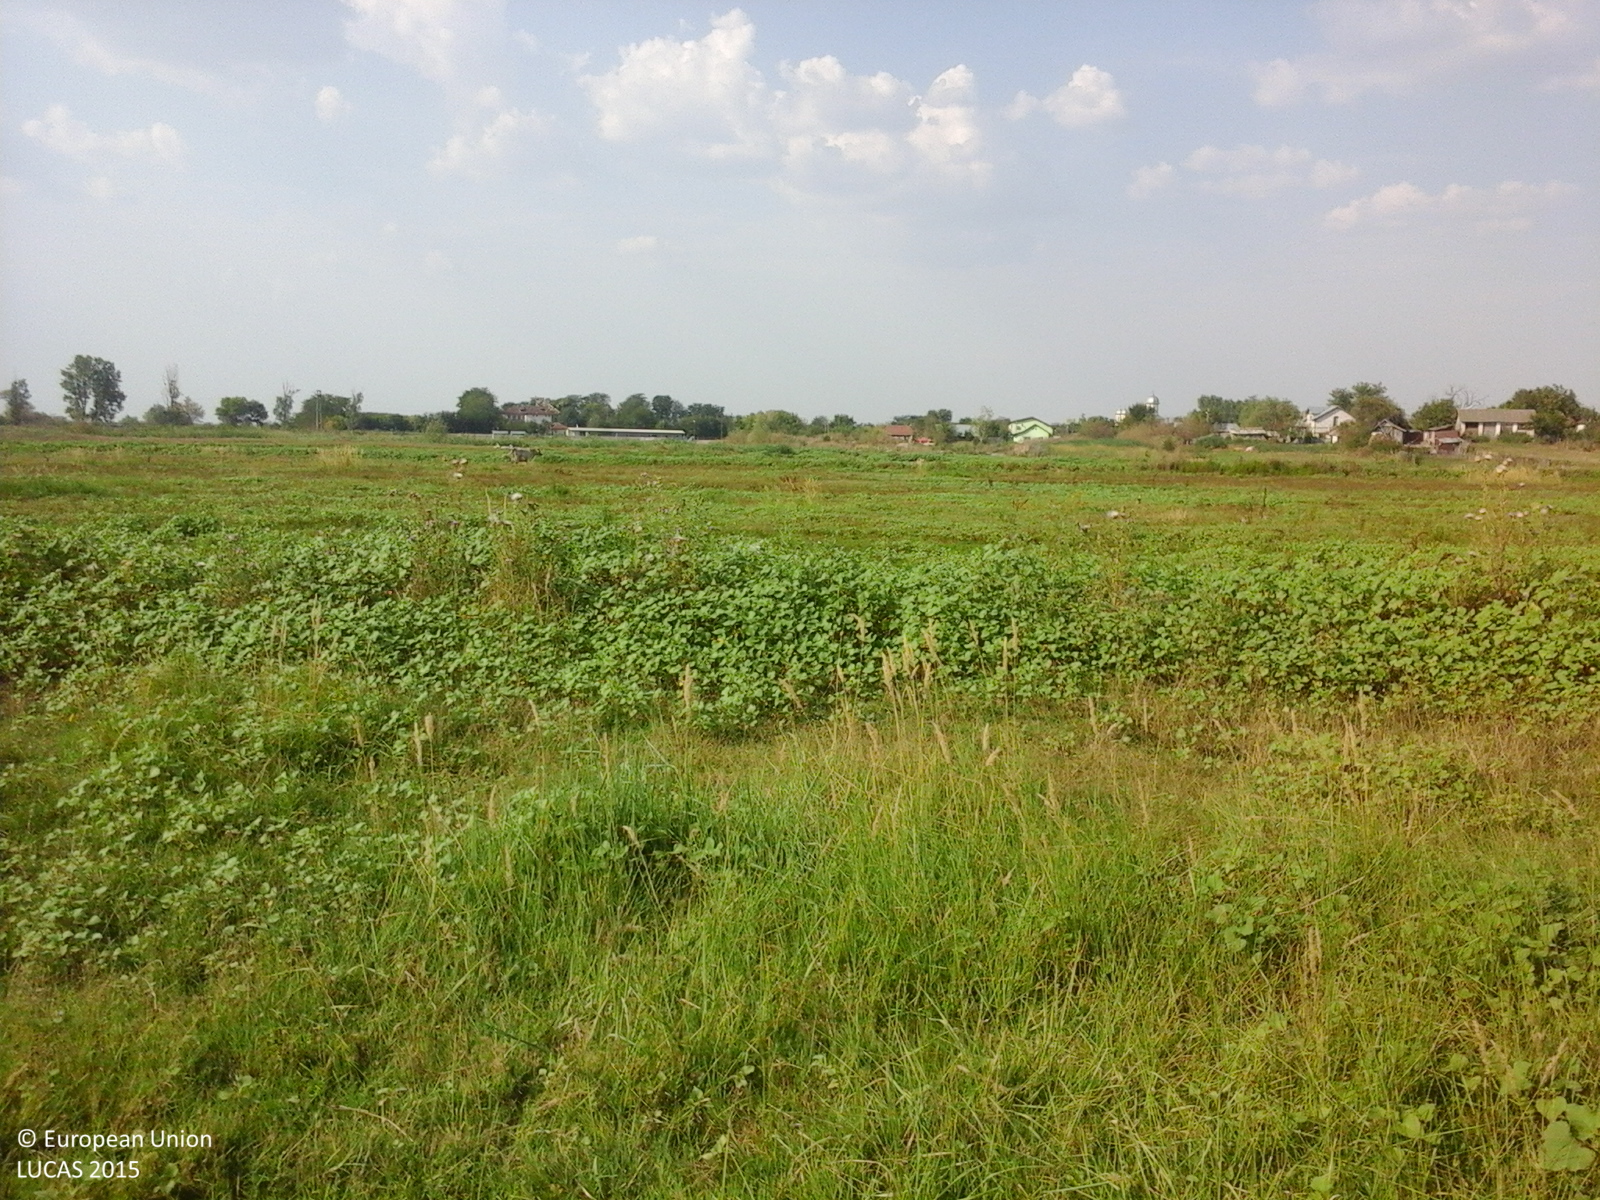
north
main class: Grassland
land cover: Spontaneously vegetated surfaces
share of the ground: > 75 %
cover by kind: herbaceous plants 100 %
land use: Agriculture (excluding fallow land and kitchen gardens)
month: August
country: RO
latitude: 43.8751
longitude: 23.7032
